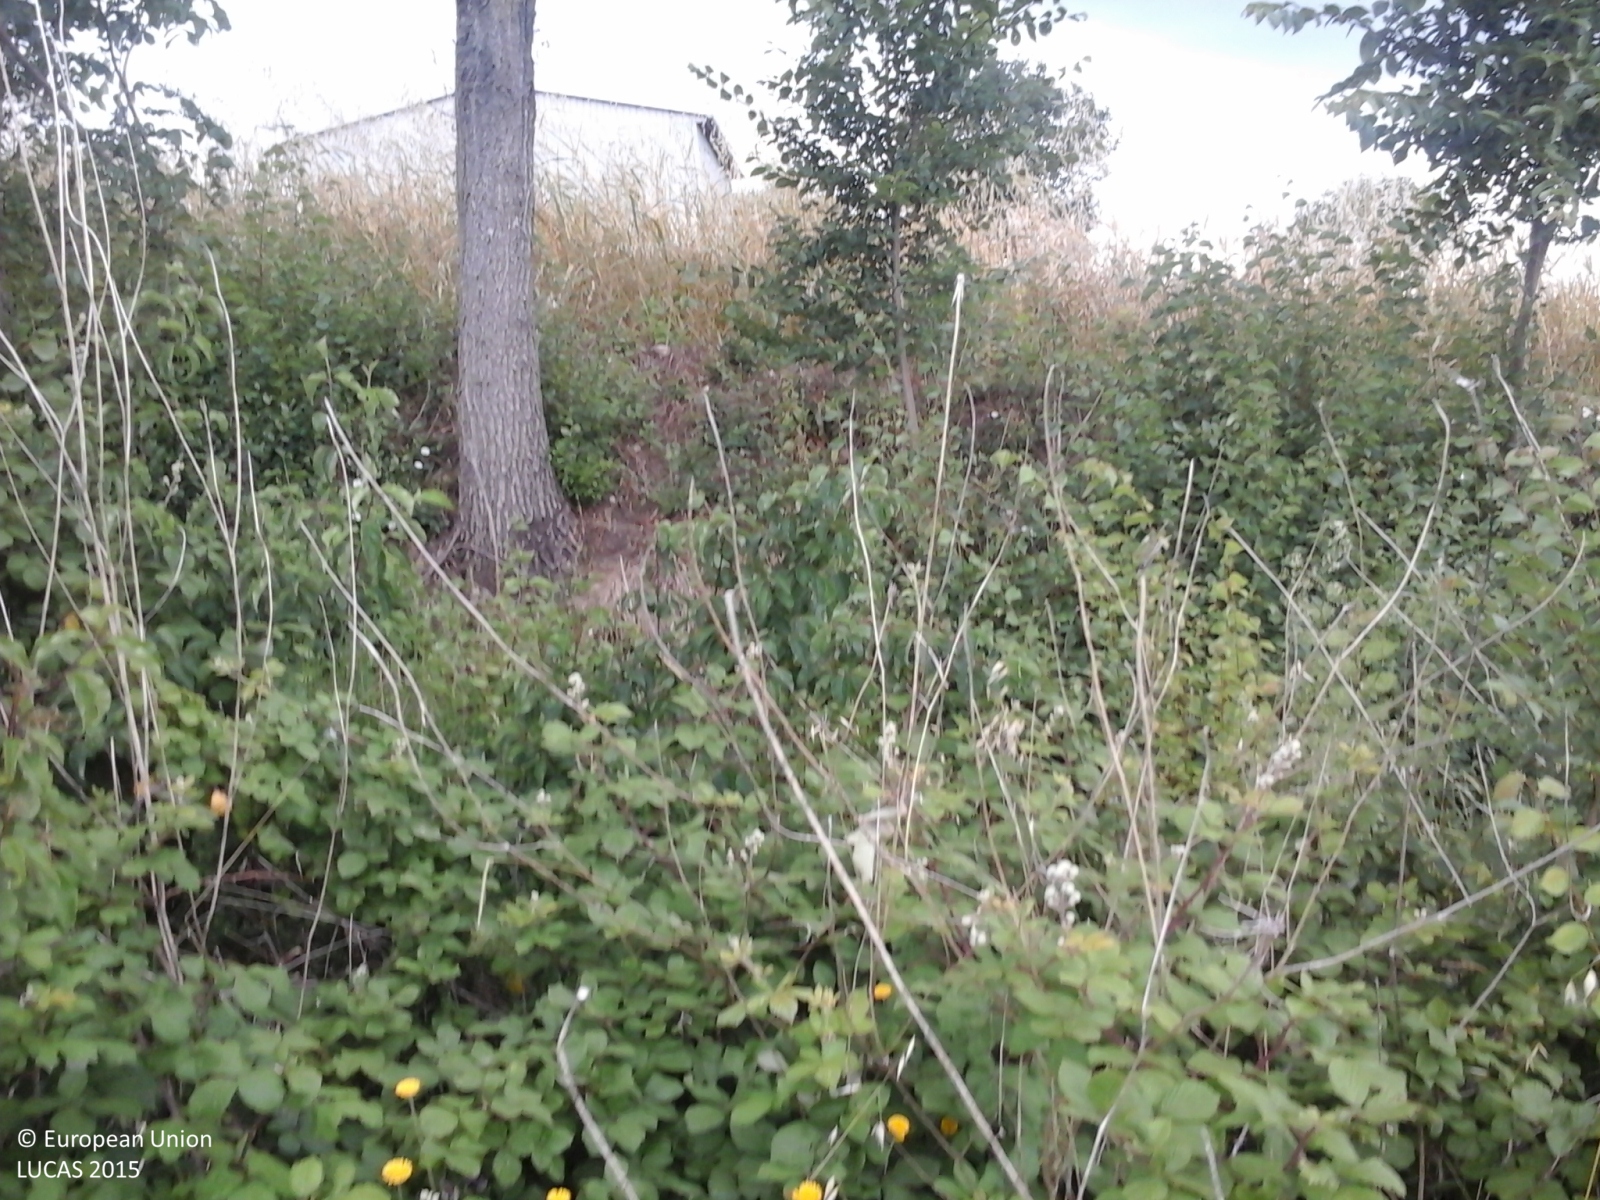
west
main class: Shrubland
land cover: Shrubland without tree cover
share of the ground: 50 - 75 %
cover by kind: shrubs 60 %, herbaceous plants 40 %
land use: Fallow land
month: June
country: IT
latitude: 41.0237
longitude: 15.0828
